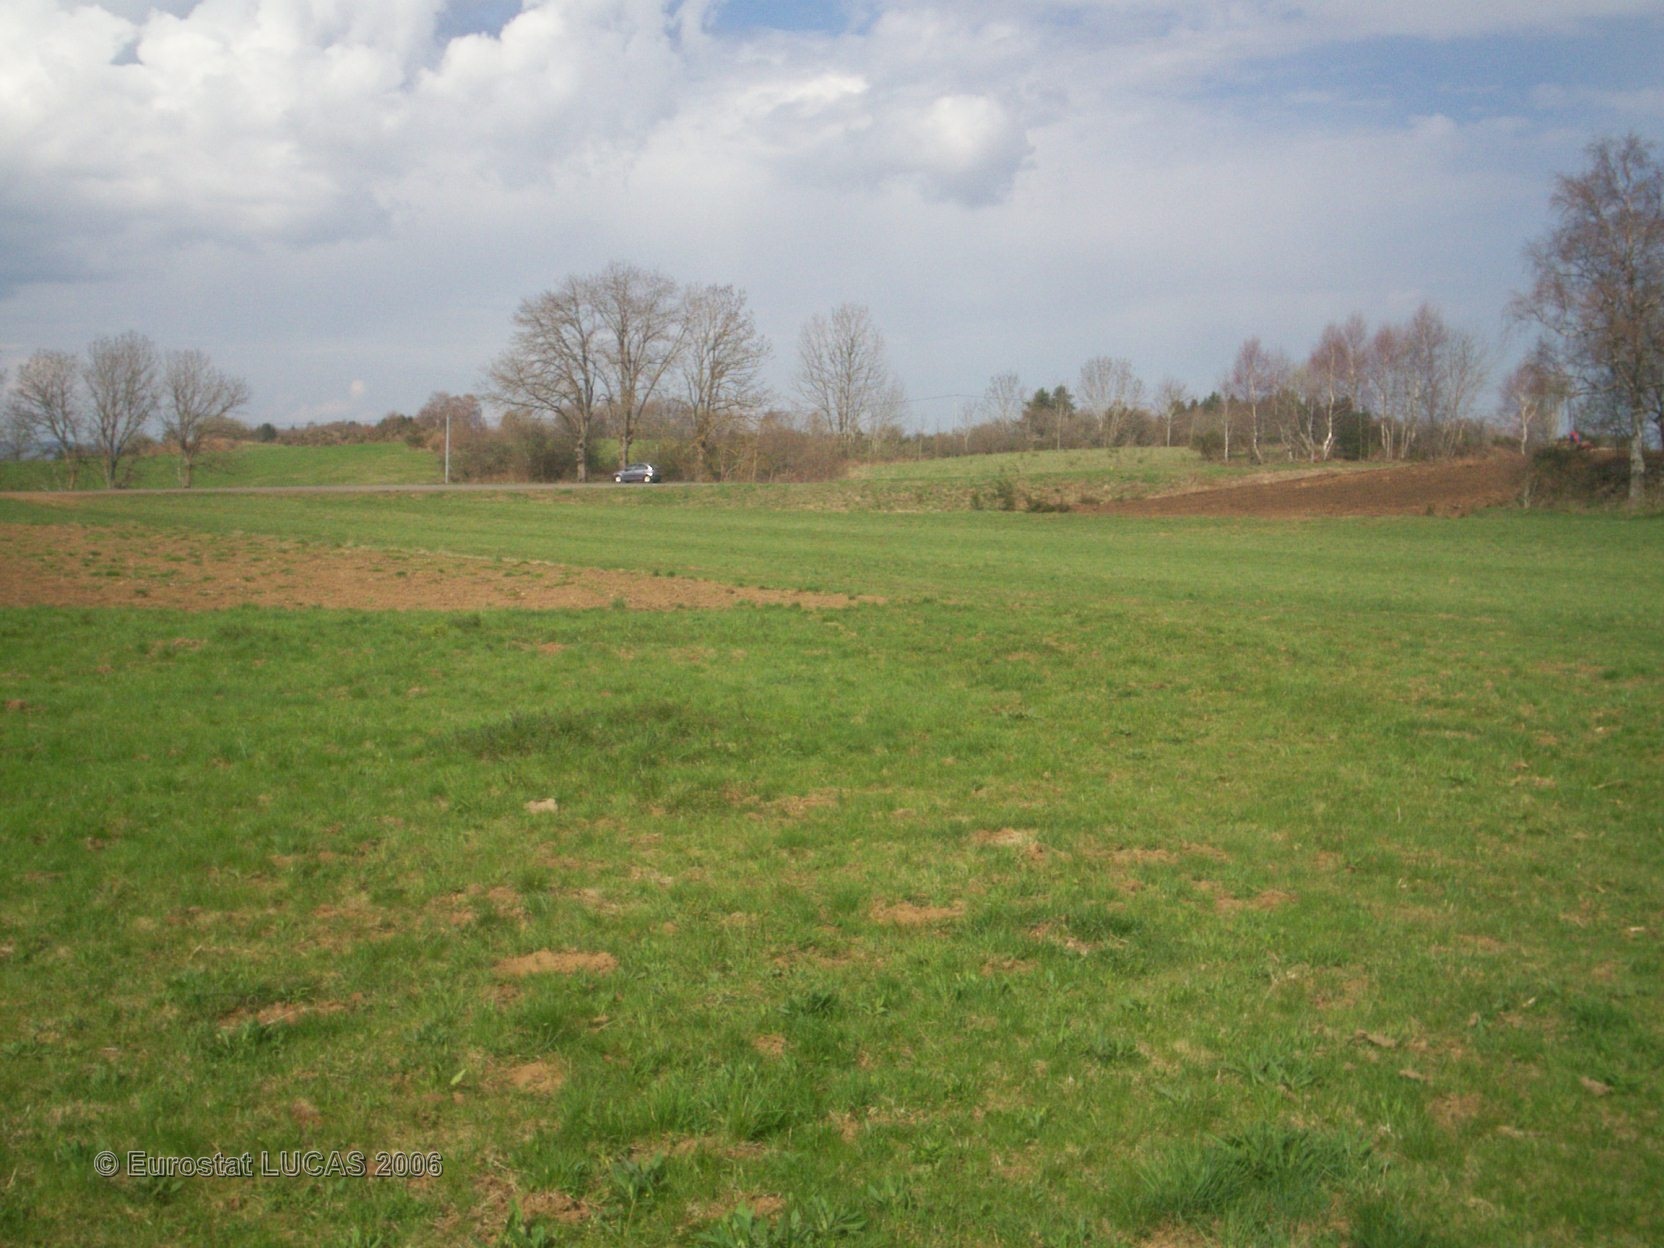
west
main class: Grassland
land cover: Grassland without tree/shrub cover
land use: Agriculture (excluding fallow land and kitchen gardens)
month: April
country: FR
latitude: 45.8459
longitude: 2.9296
